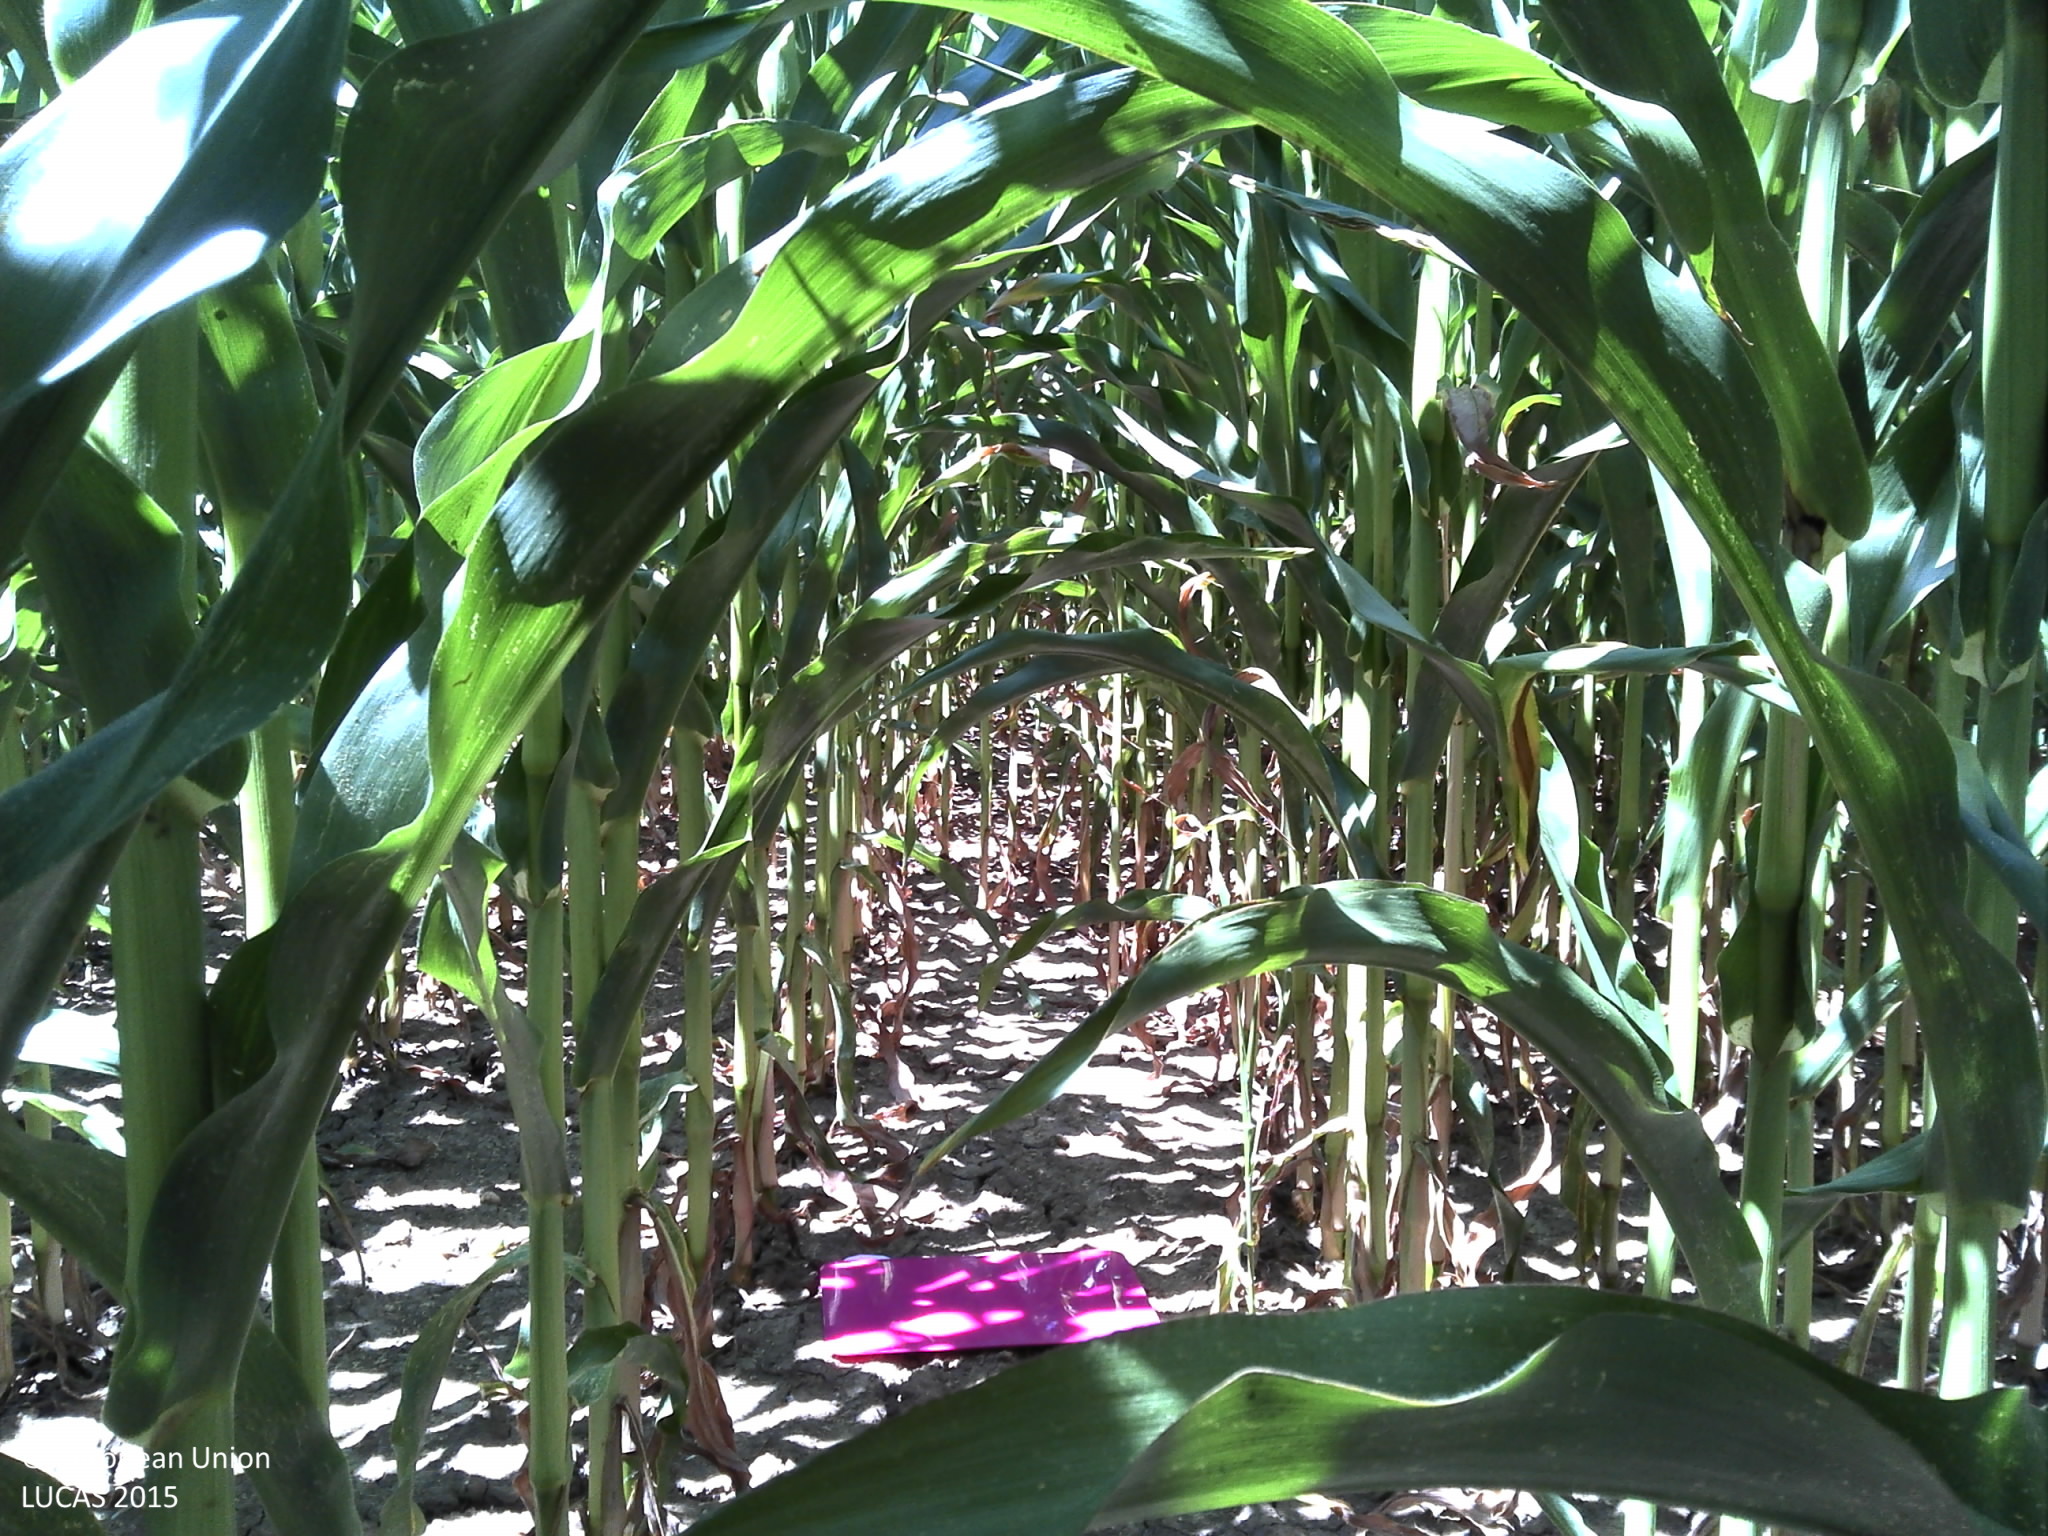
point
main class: Cropland
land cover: Maize
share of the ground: > 75 %
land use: Agriculture (excluding fallow land and kitchen gardens)
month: July
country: FR
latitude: 45.4841
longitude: -1.0685
